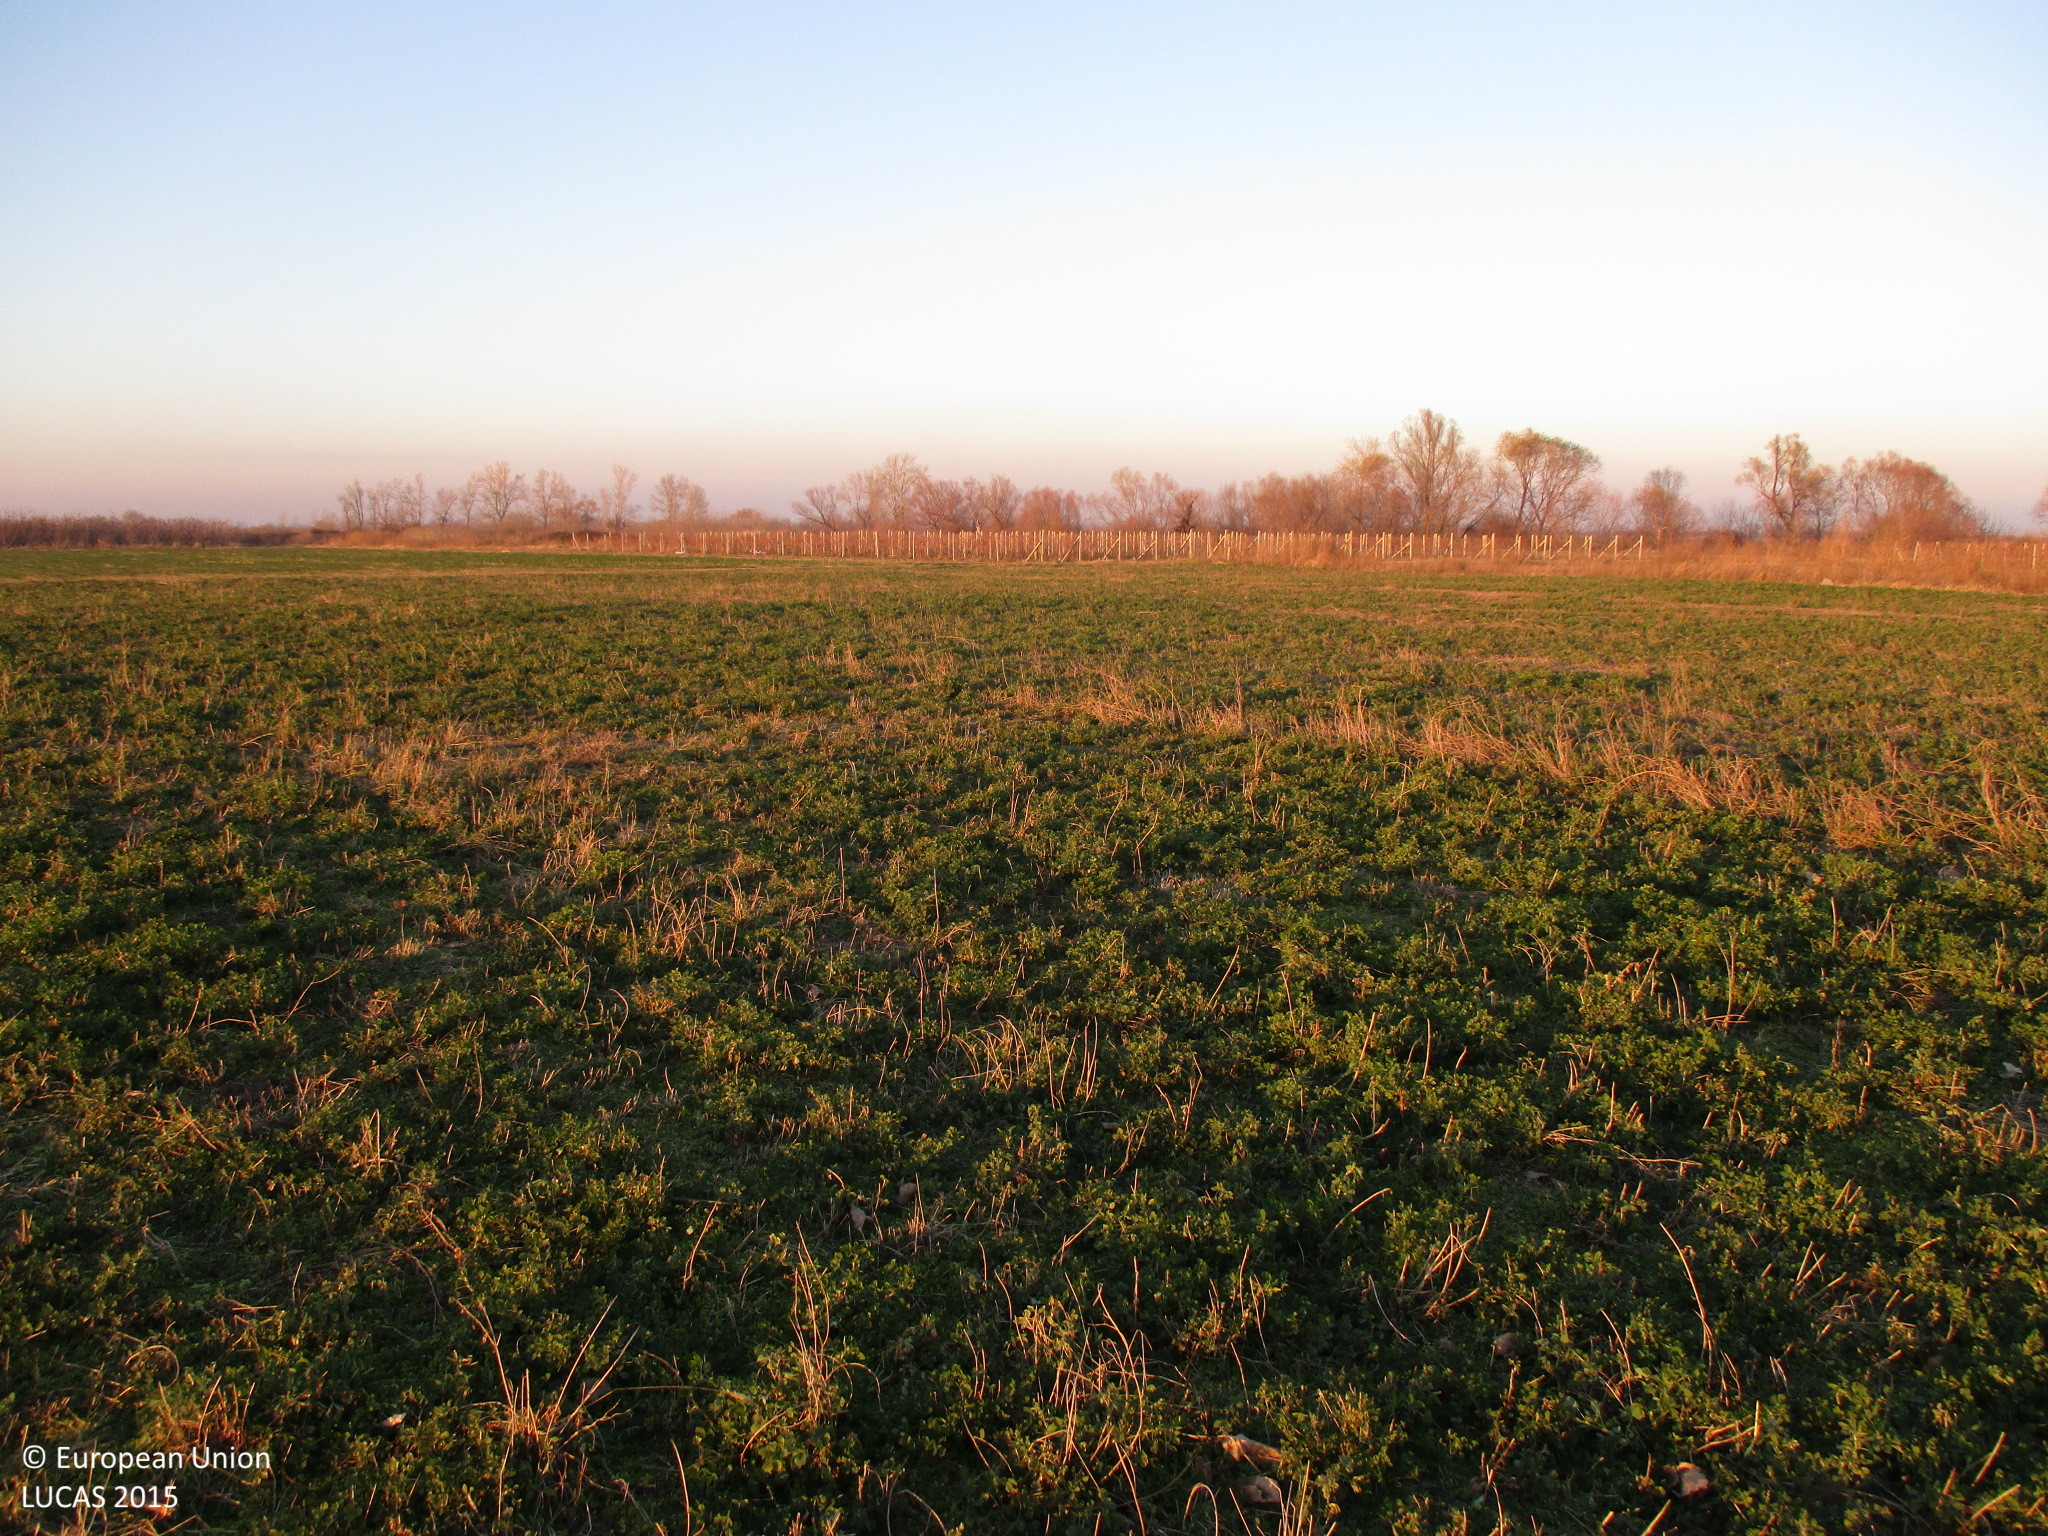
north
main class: Cropland
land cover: Lucerne
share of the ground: 50 - 75 %
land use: Agriculture (excluding fallow land and kitchen gardens)
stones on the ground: < 10 %
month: December
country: BG
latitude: 42.1245
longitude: 24.5759
